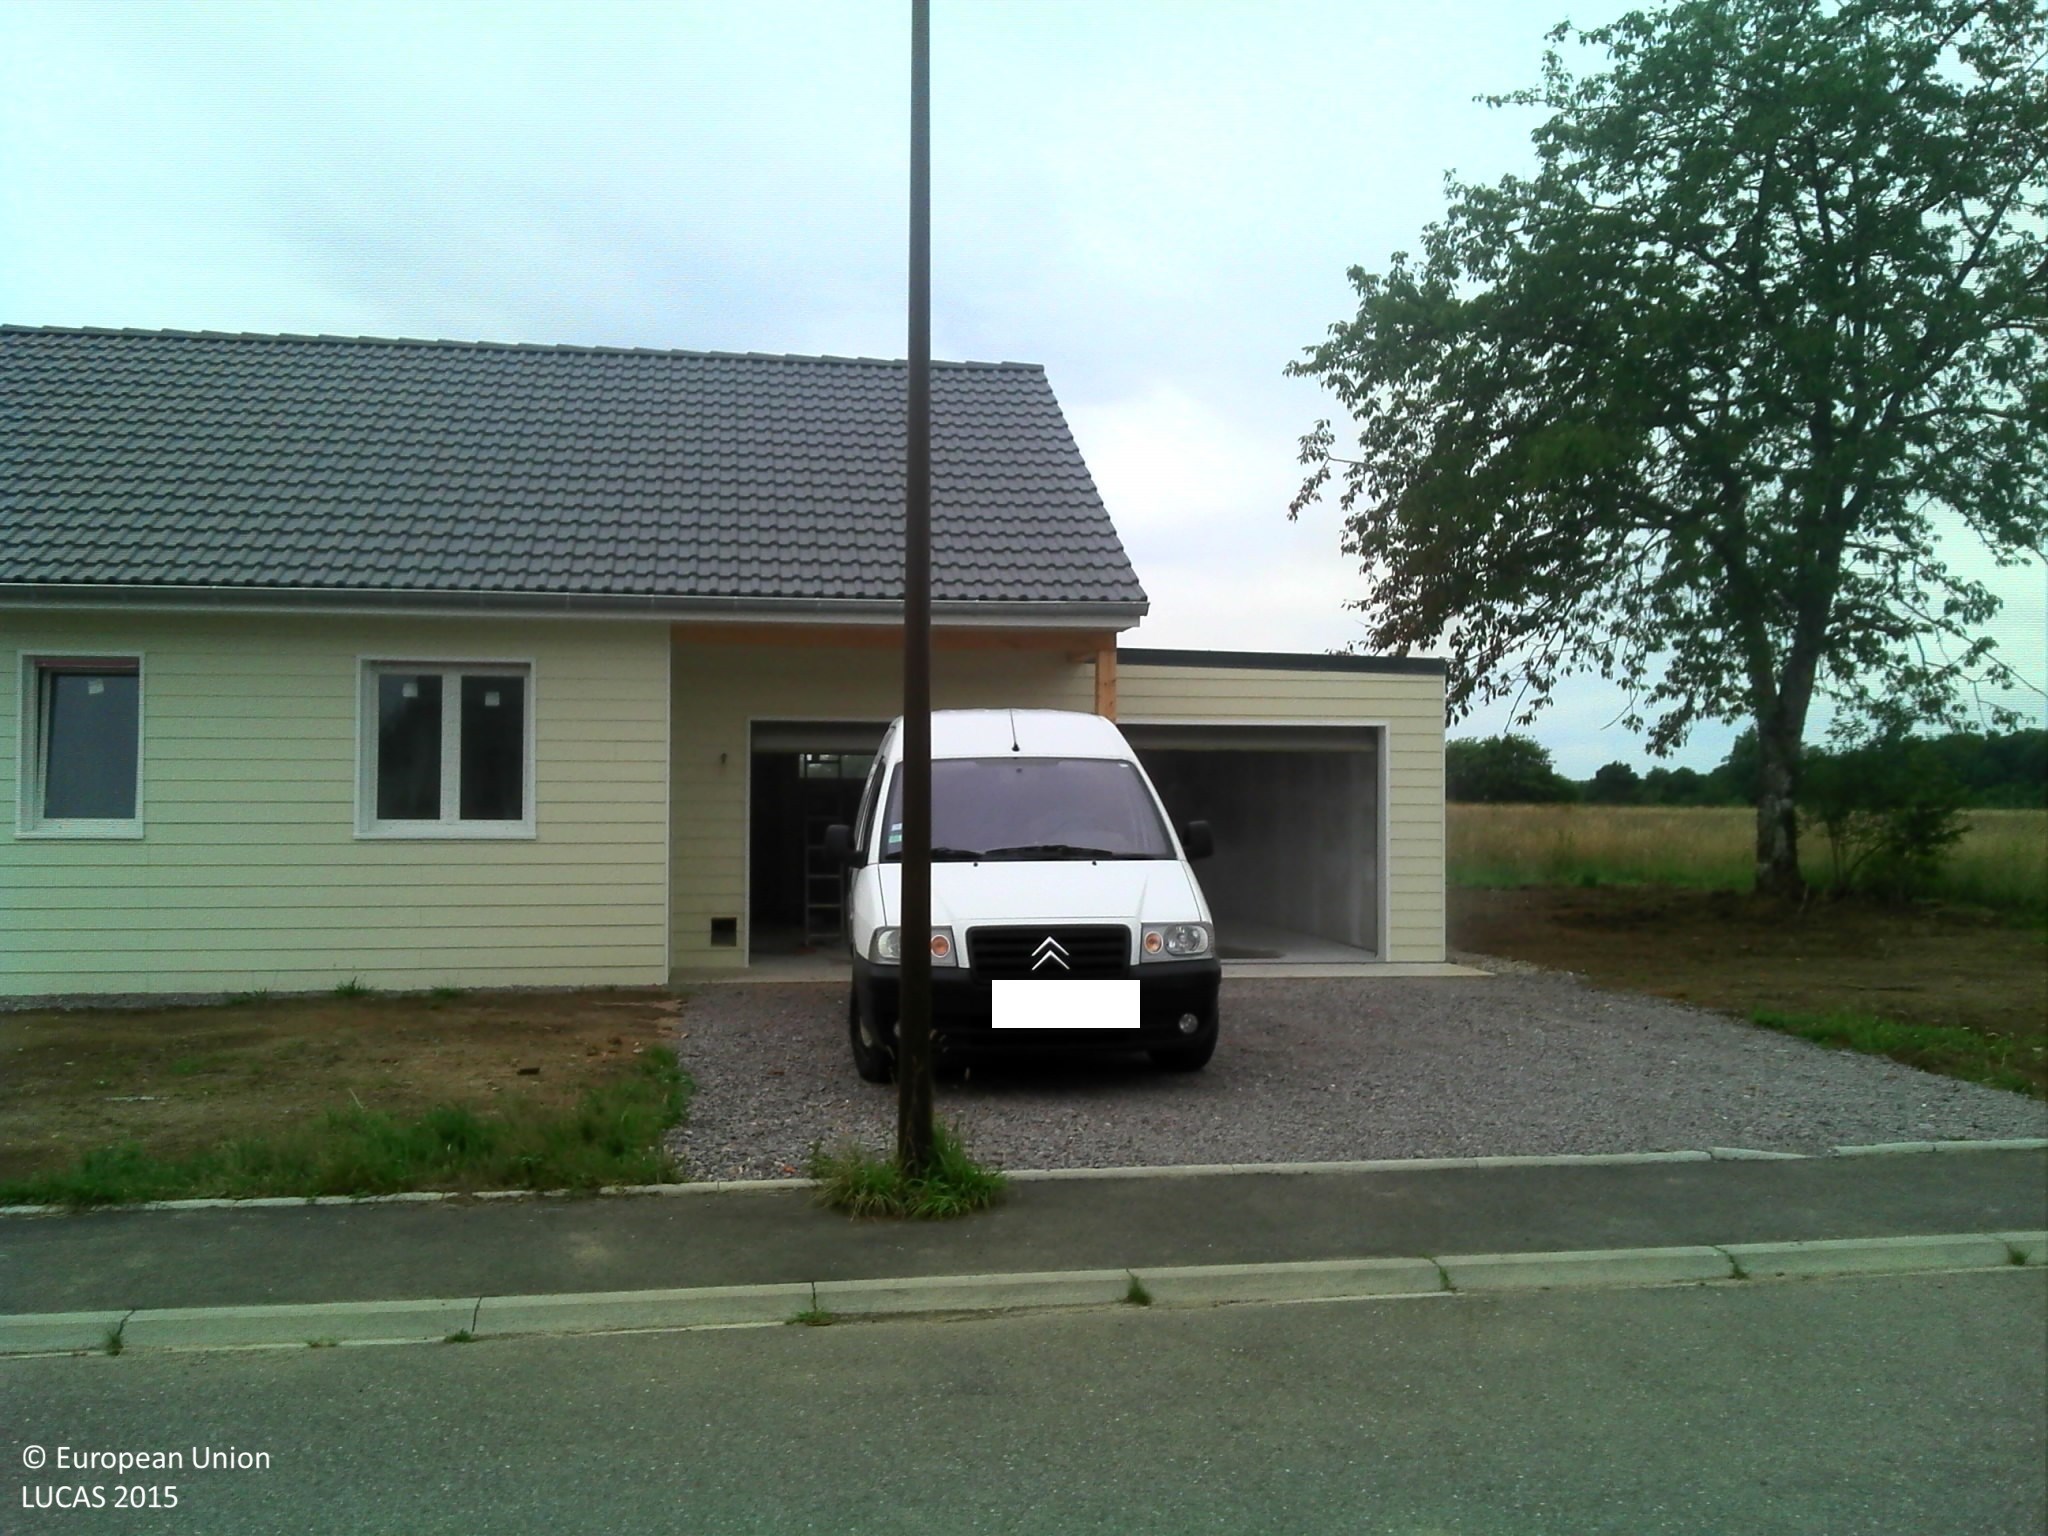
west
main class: Grassland
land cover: Grassland without tree/shrub cover
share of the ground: > 75 %
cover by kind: herbaceous plants 100 %
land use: Residential
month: June
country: FR
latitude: 47.8920
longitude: 6.3229
